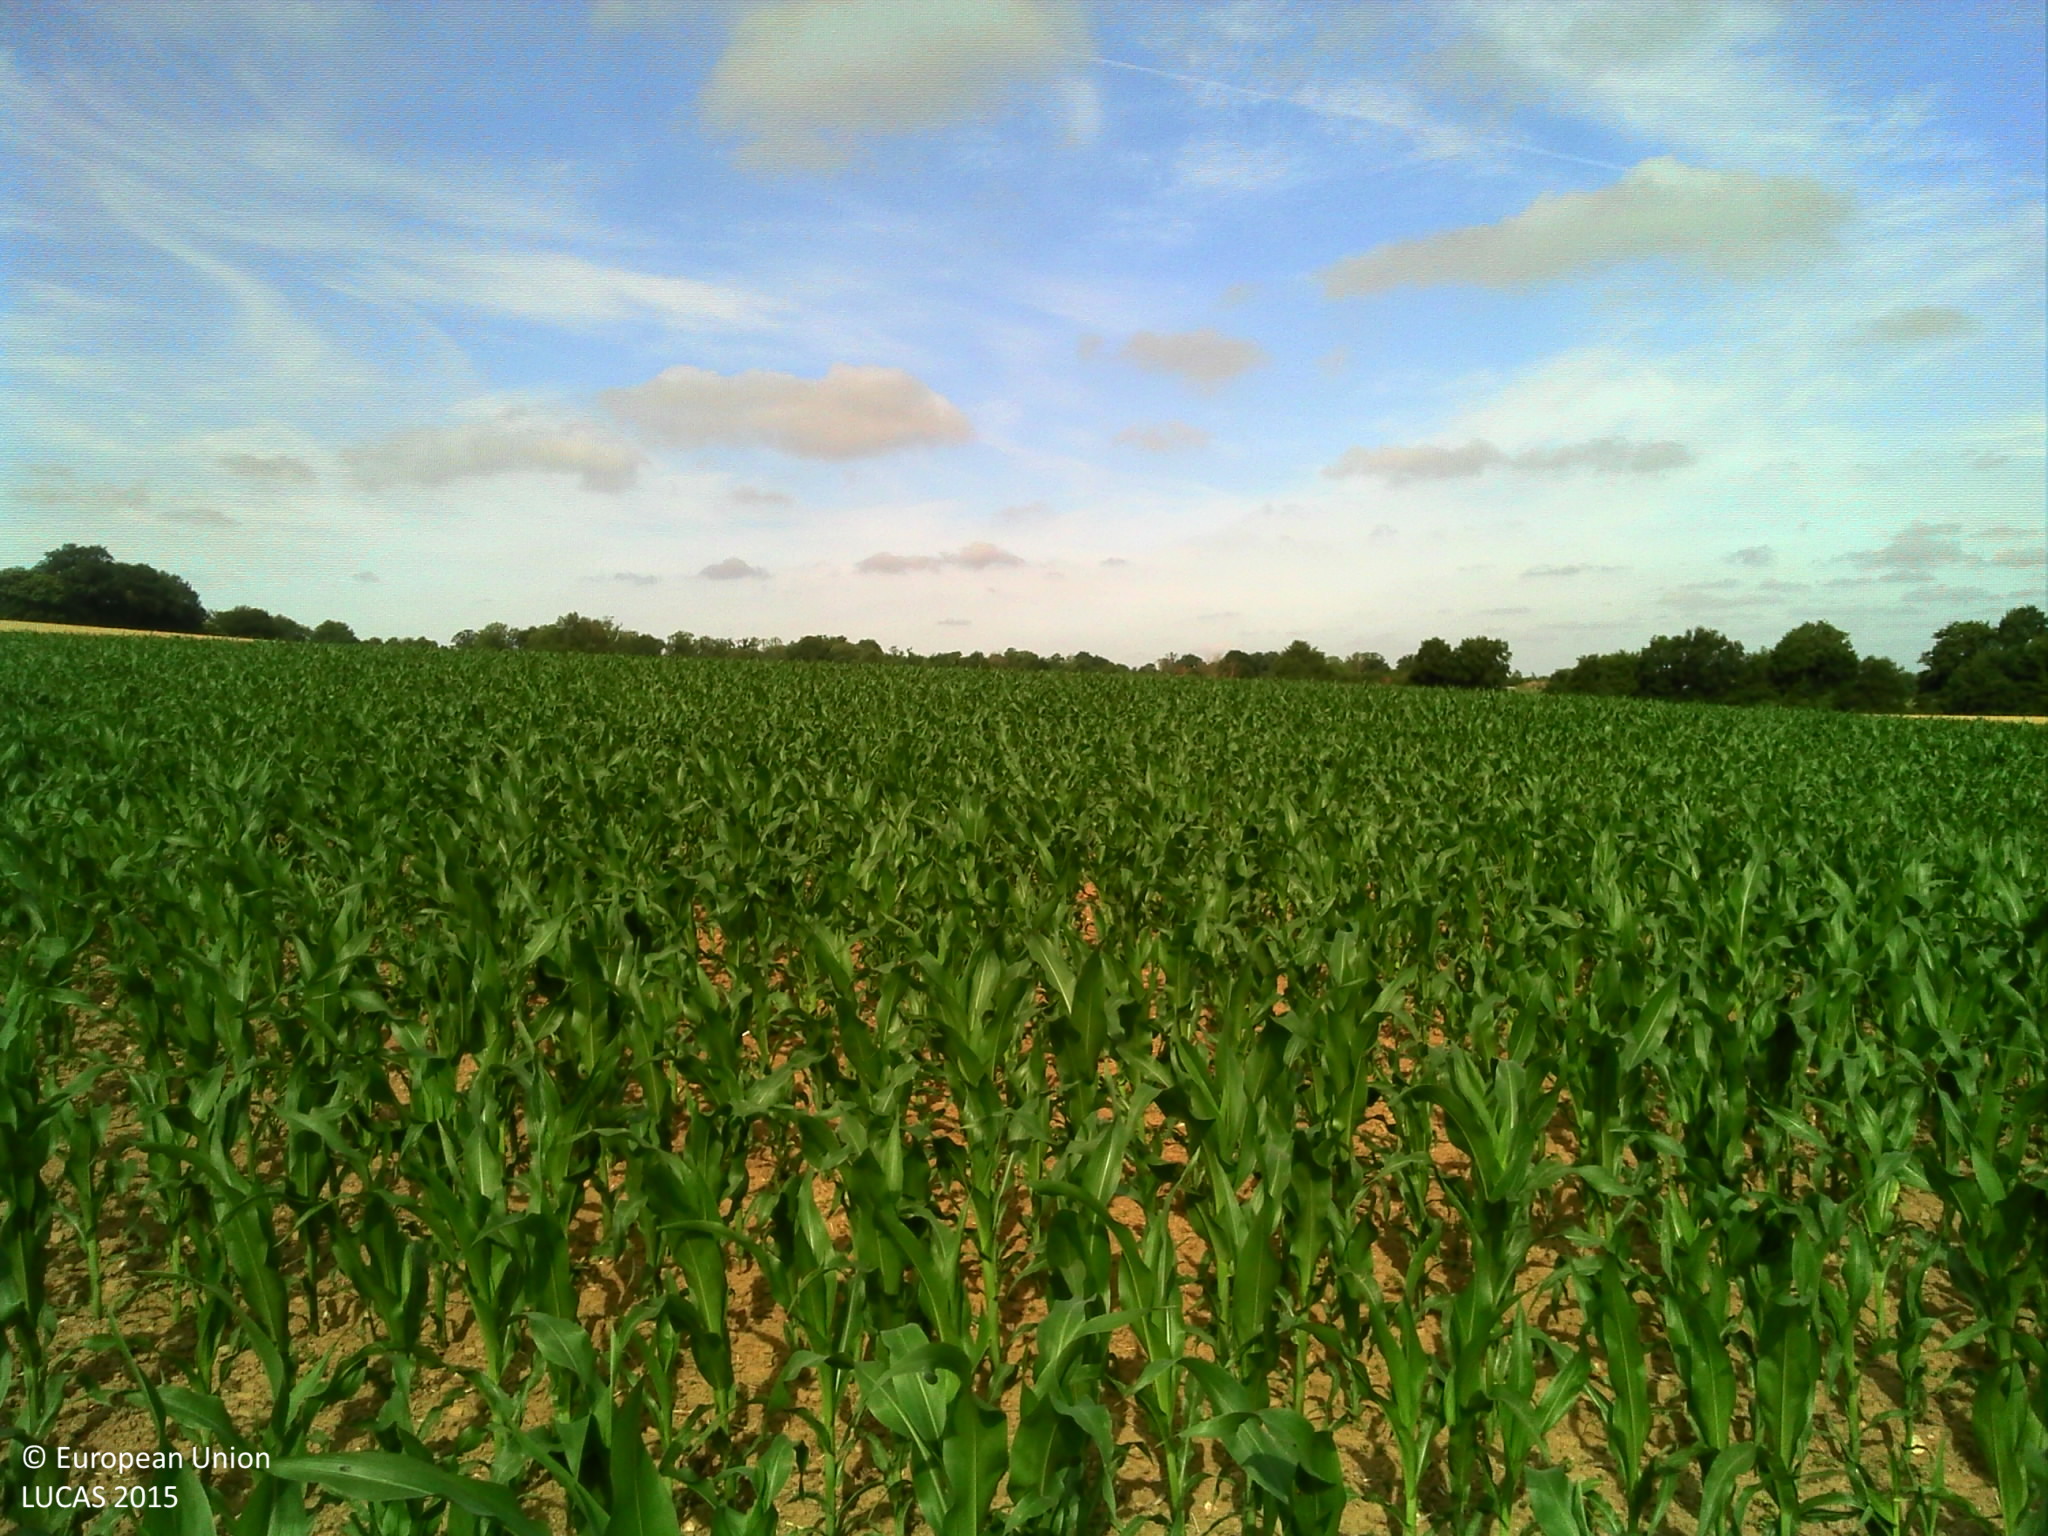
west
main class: Cropland
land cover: Rape and turnip rape
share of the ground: > 75 %
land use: Agriculture (excluding fallow land and kitchen gardens)
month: June
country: FR
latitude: 47.8830
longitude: -1.5862
